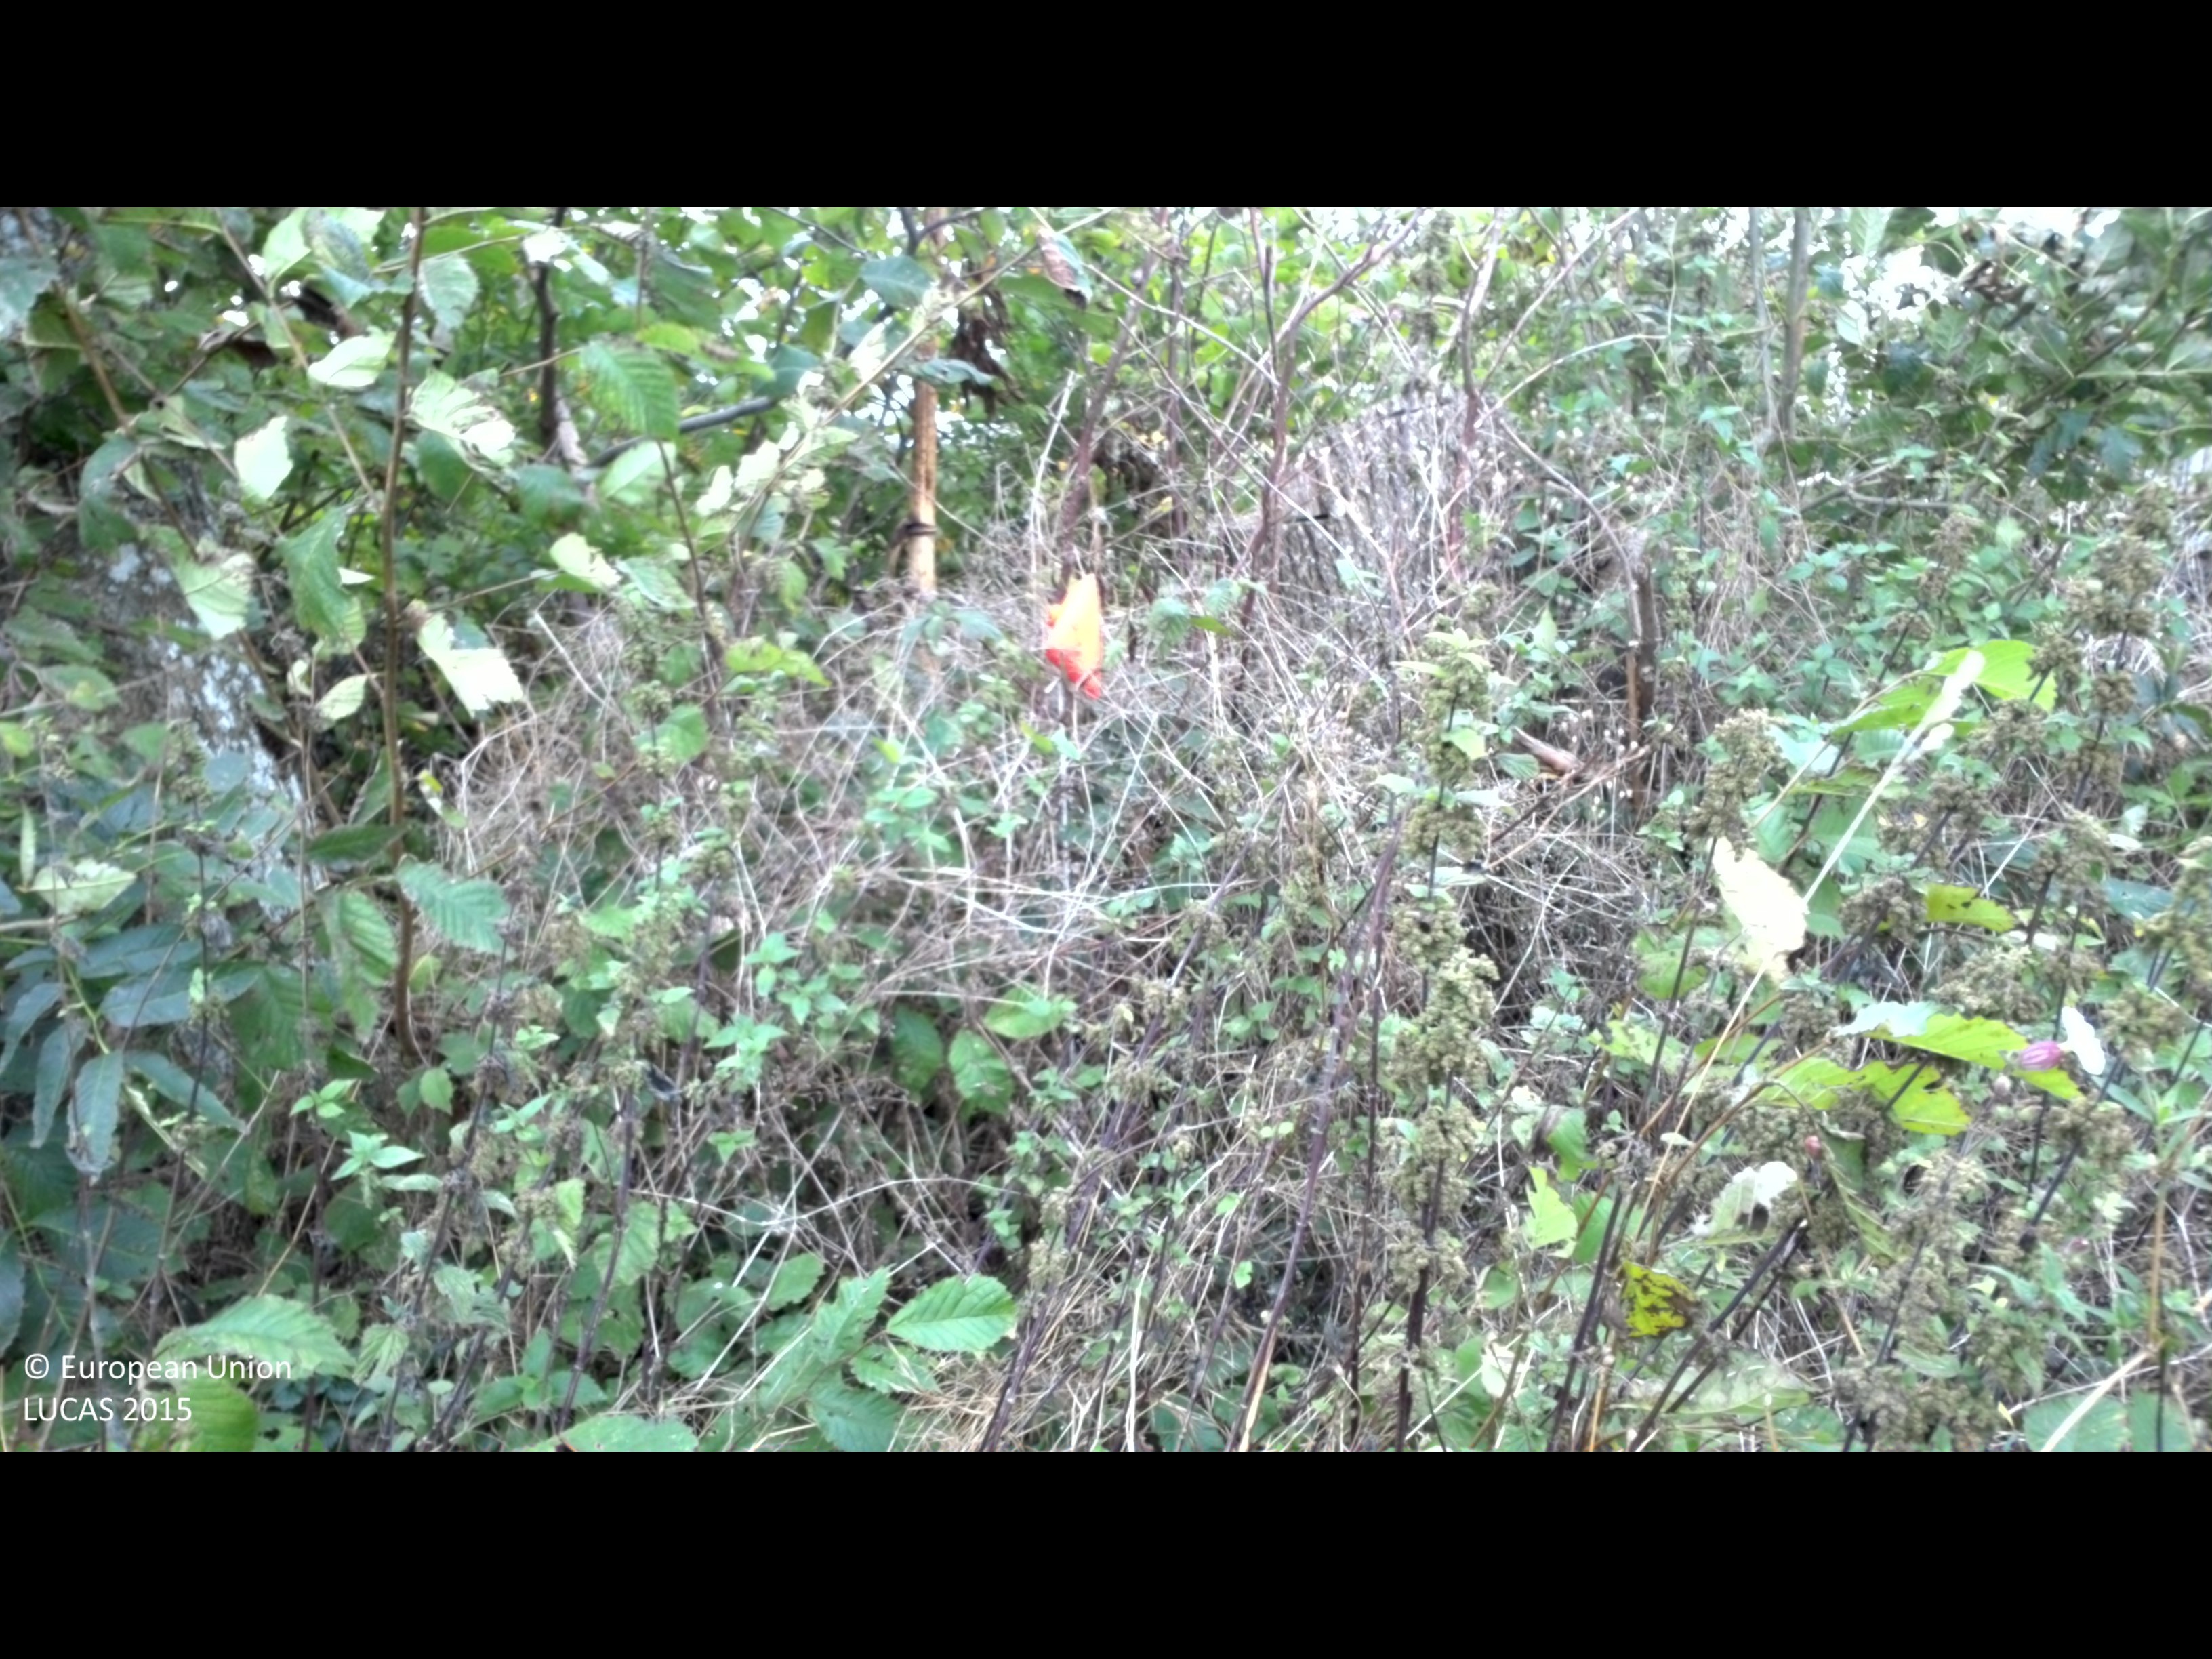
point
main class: Cropland
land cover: Potatoes
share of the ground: > 75 %
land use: Agriculture (excluding fallow land and kitchen gardens)
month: September
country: SE
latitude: 56.0506
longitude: 14.0921
